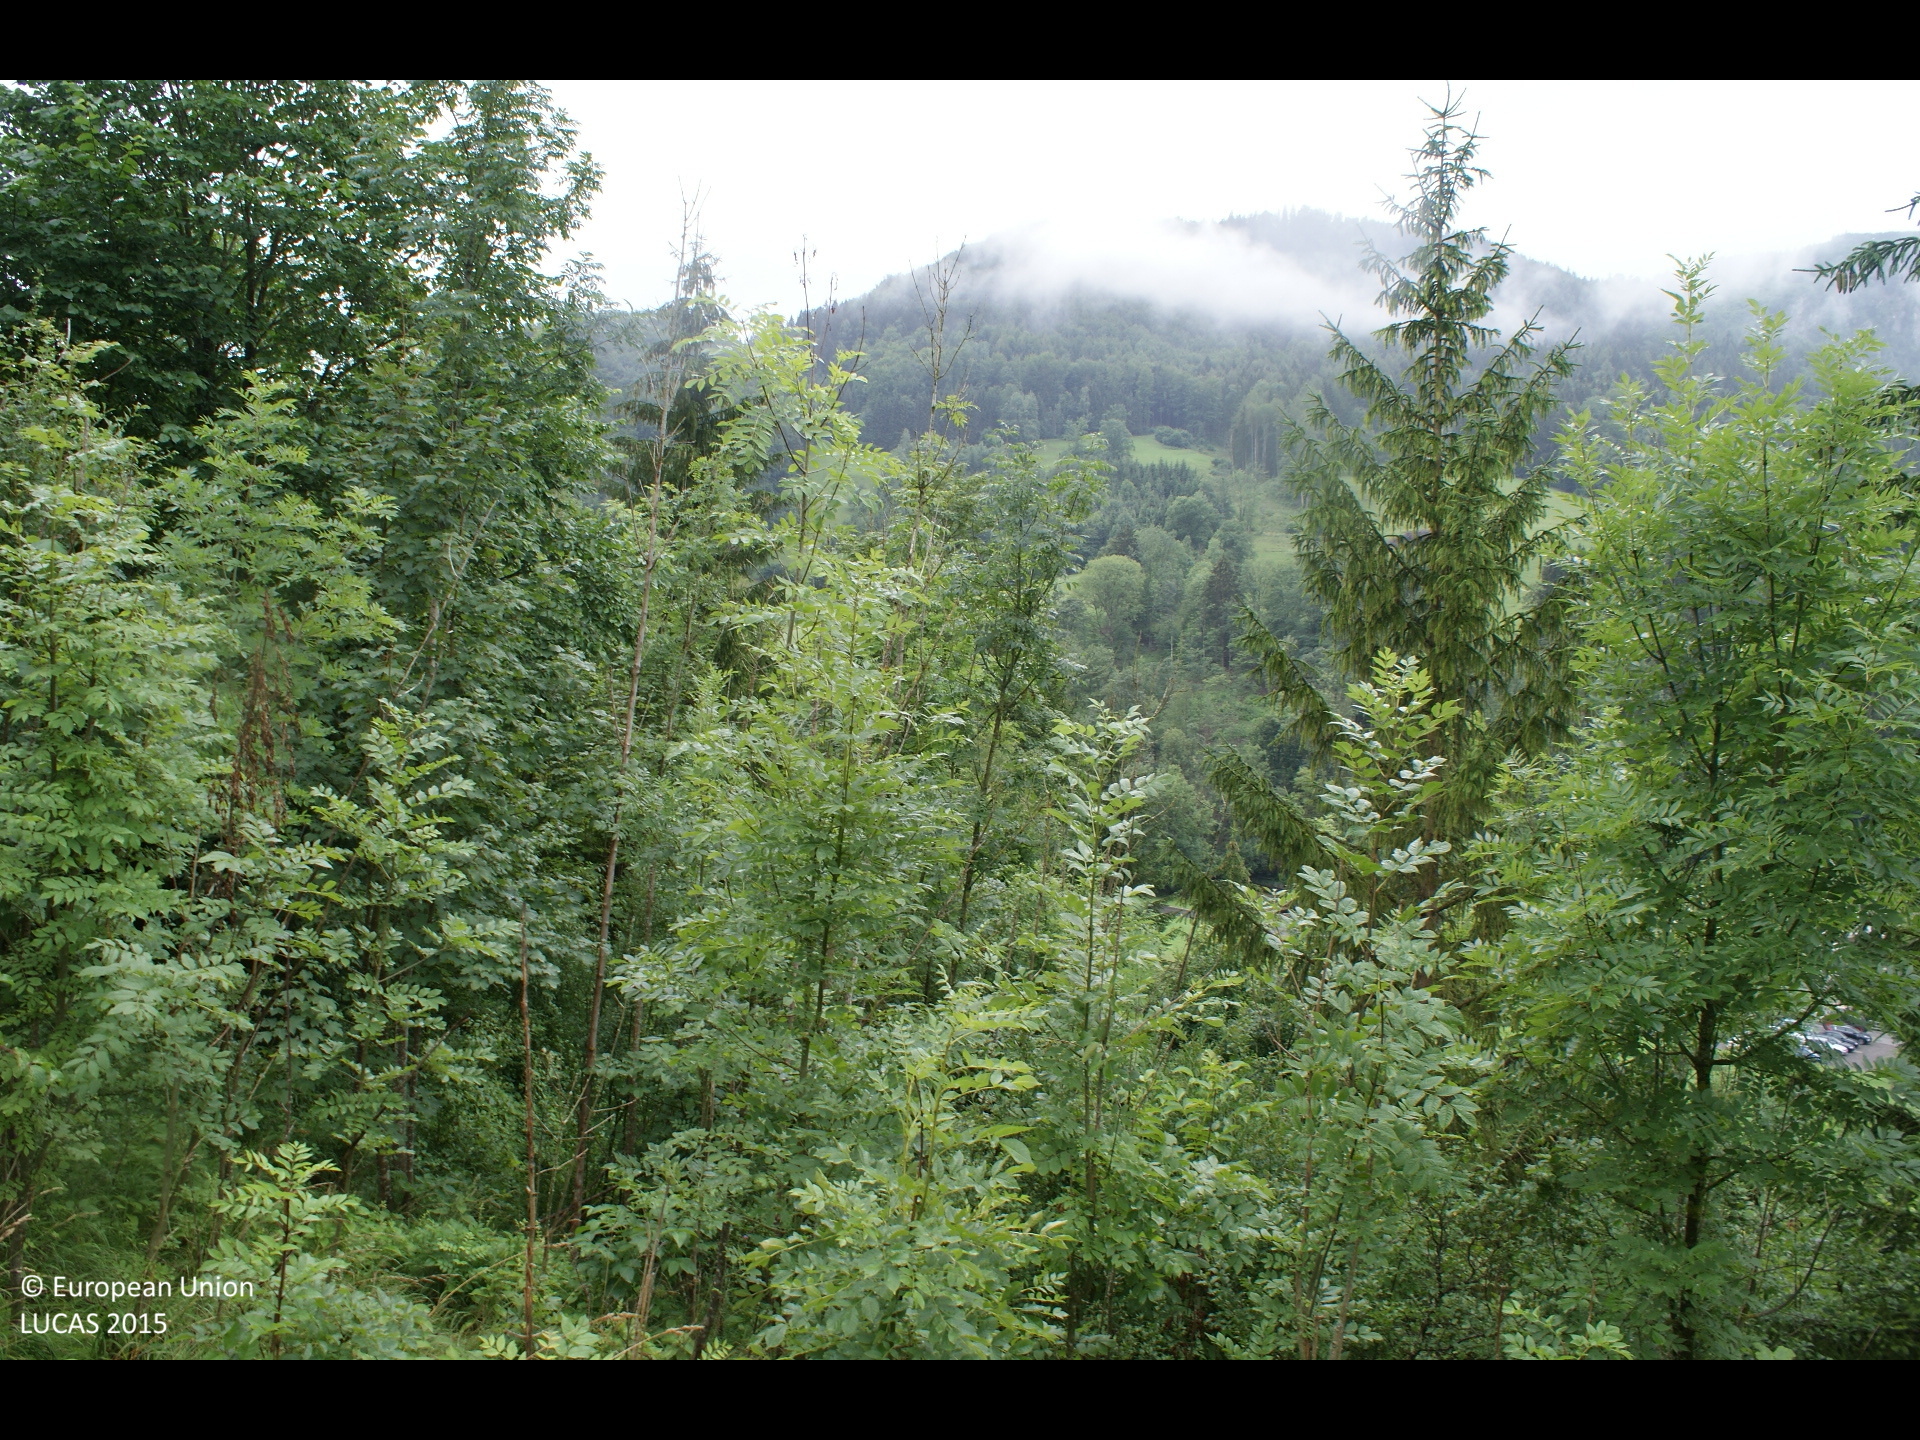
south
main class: Shrubland
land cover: Shrubland with sparse tree cover
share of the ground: 50 - 75 %
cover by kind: shrubs 60 %, herbaceous plants 35 %, broadleaved forest trees 5 %
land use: Forestry
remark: Clear cut
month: July
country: AT
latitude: 47.9505
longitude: 14.9415
